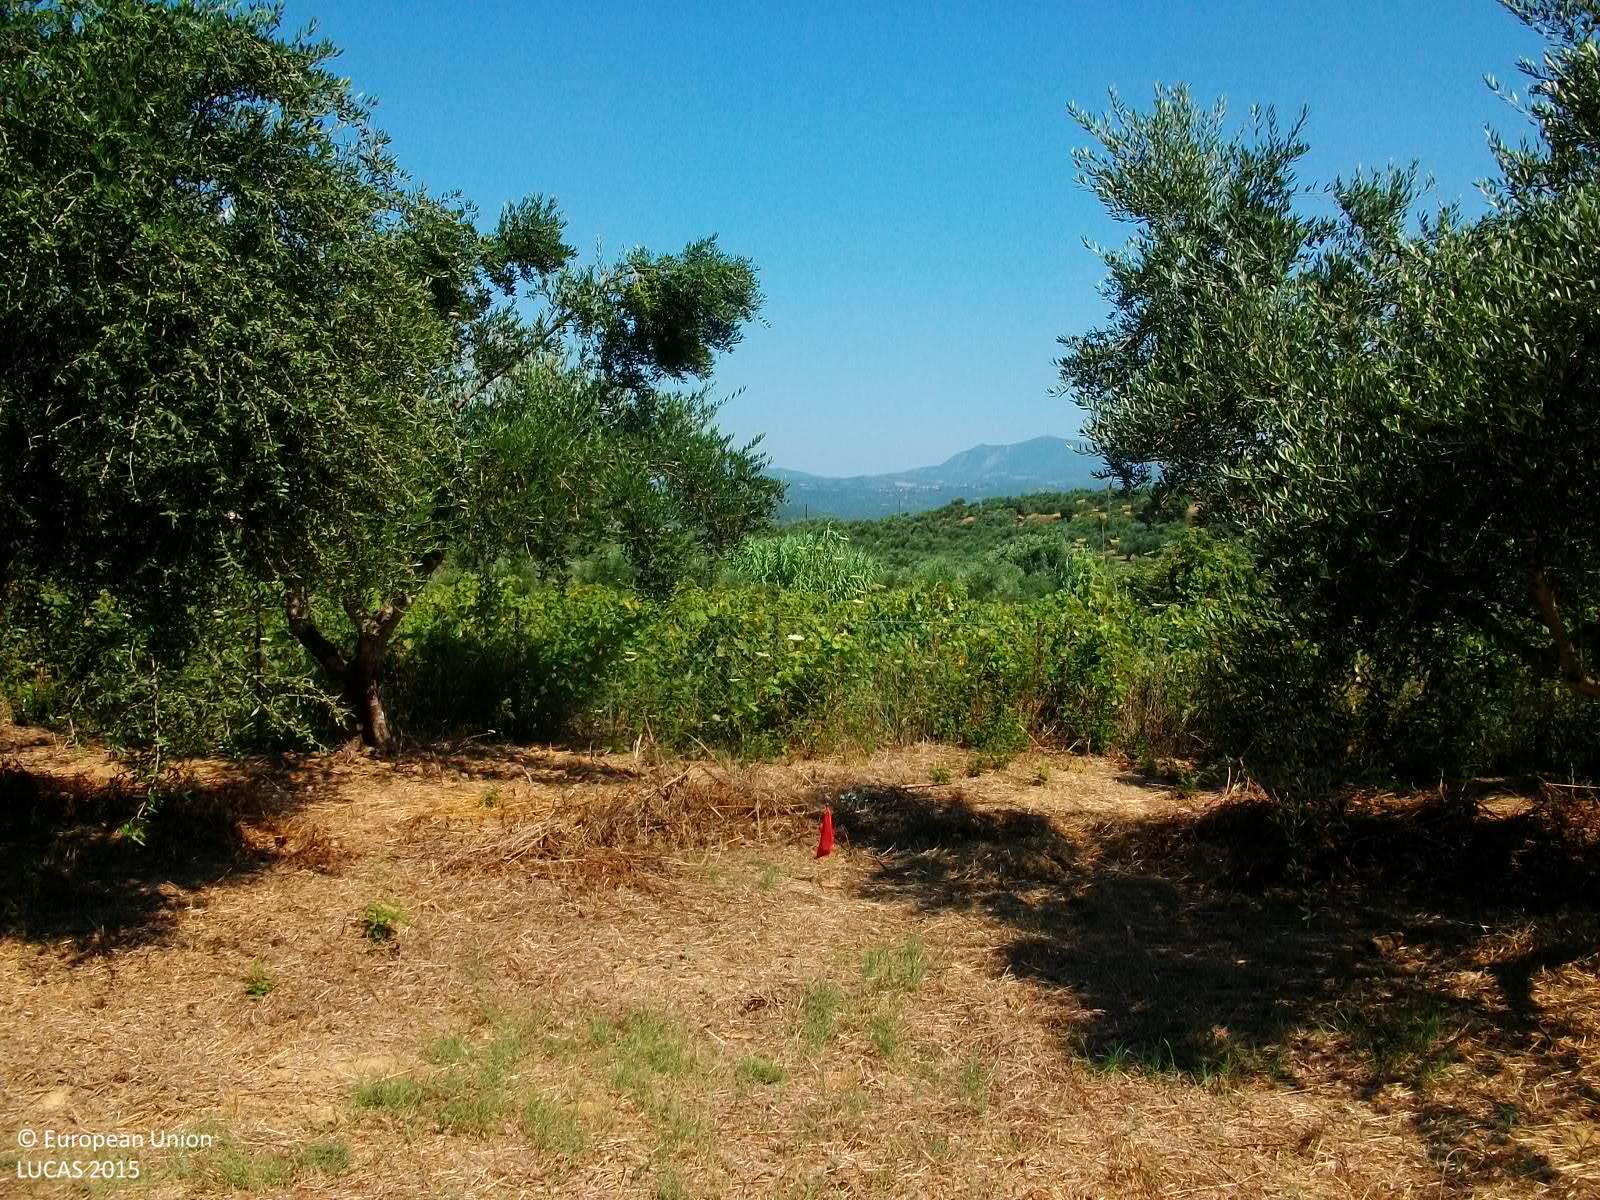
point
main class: Cropland
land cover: Olive groves
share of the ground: 25 - 50 %
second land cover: Spontaneously vegetated surfaces
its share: > 75 %
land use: Agriculture (excluding fallow land and kitchen gardens)
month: July
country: GR
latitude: 36.8130
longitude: 21.9100
